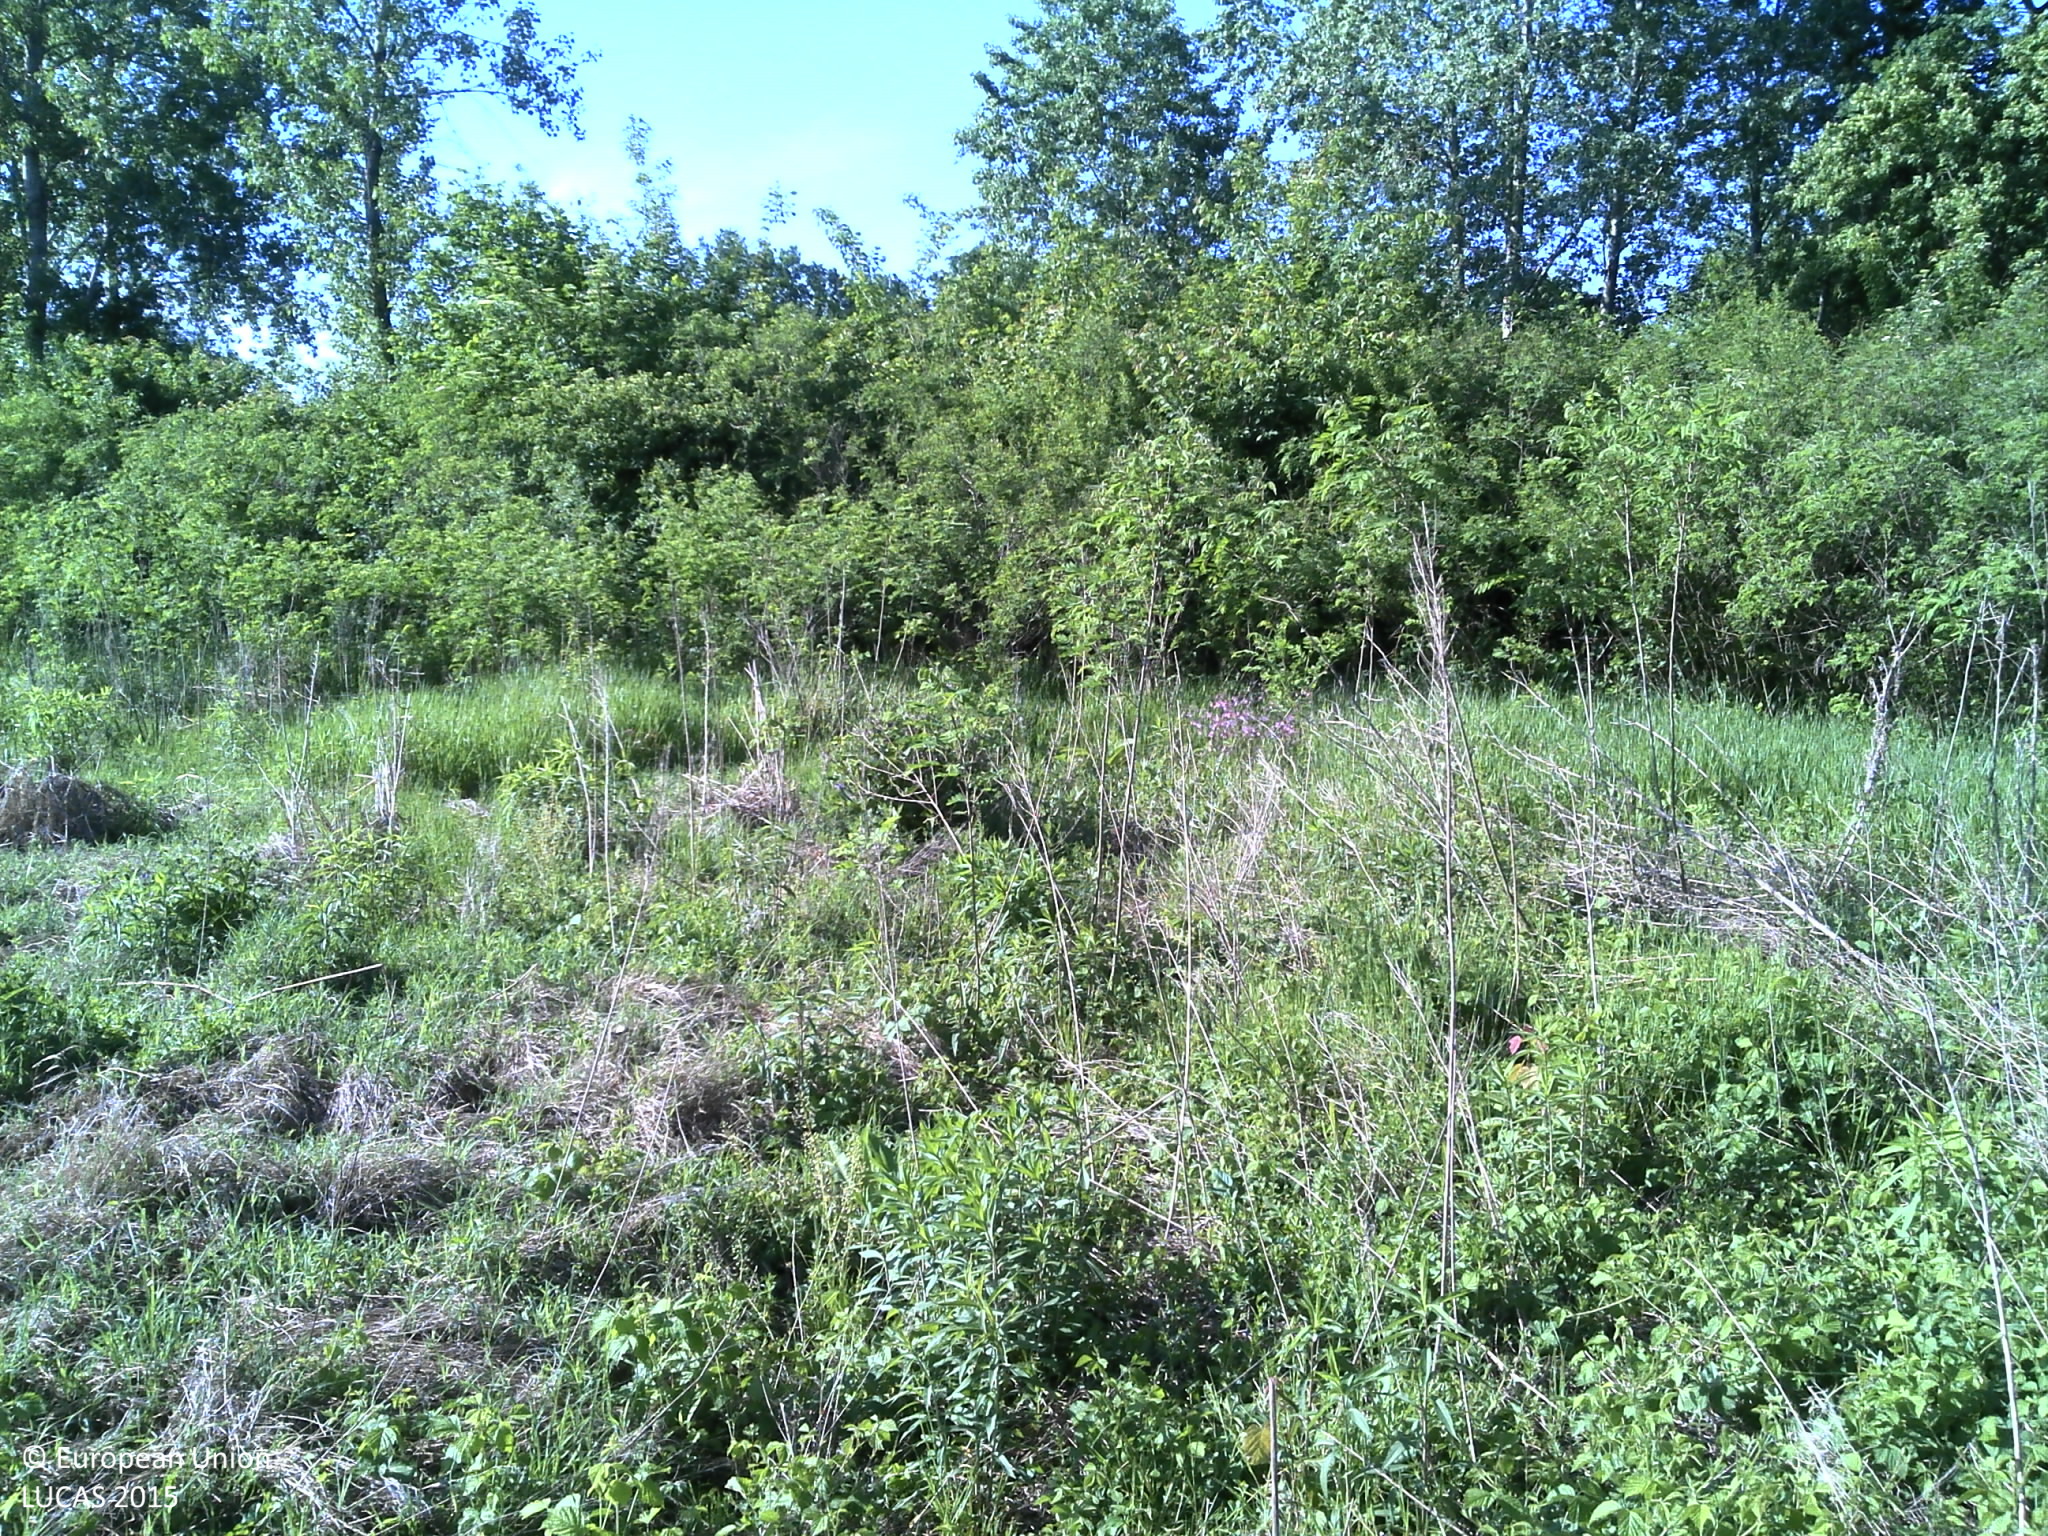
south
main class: Shrubland
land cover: Shrubland with sparse tree cover
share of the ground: > 75 %
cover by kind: shrubs 90 %, broadleaved forest trees 5 %, herbaceous plants 5 %
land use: Semi-natural and natural areas not in use
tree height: > 5 m
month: May
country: HR
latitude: 45.1302
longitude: 18.4342
